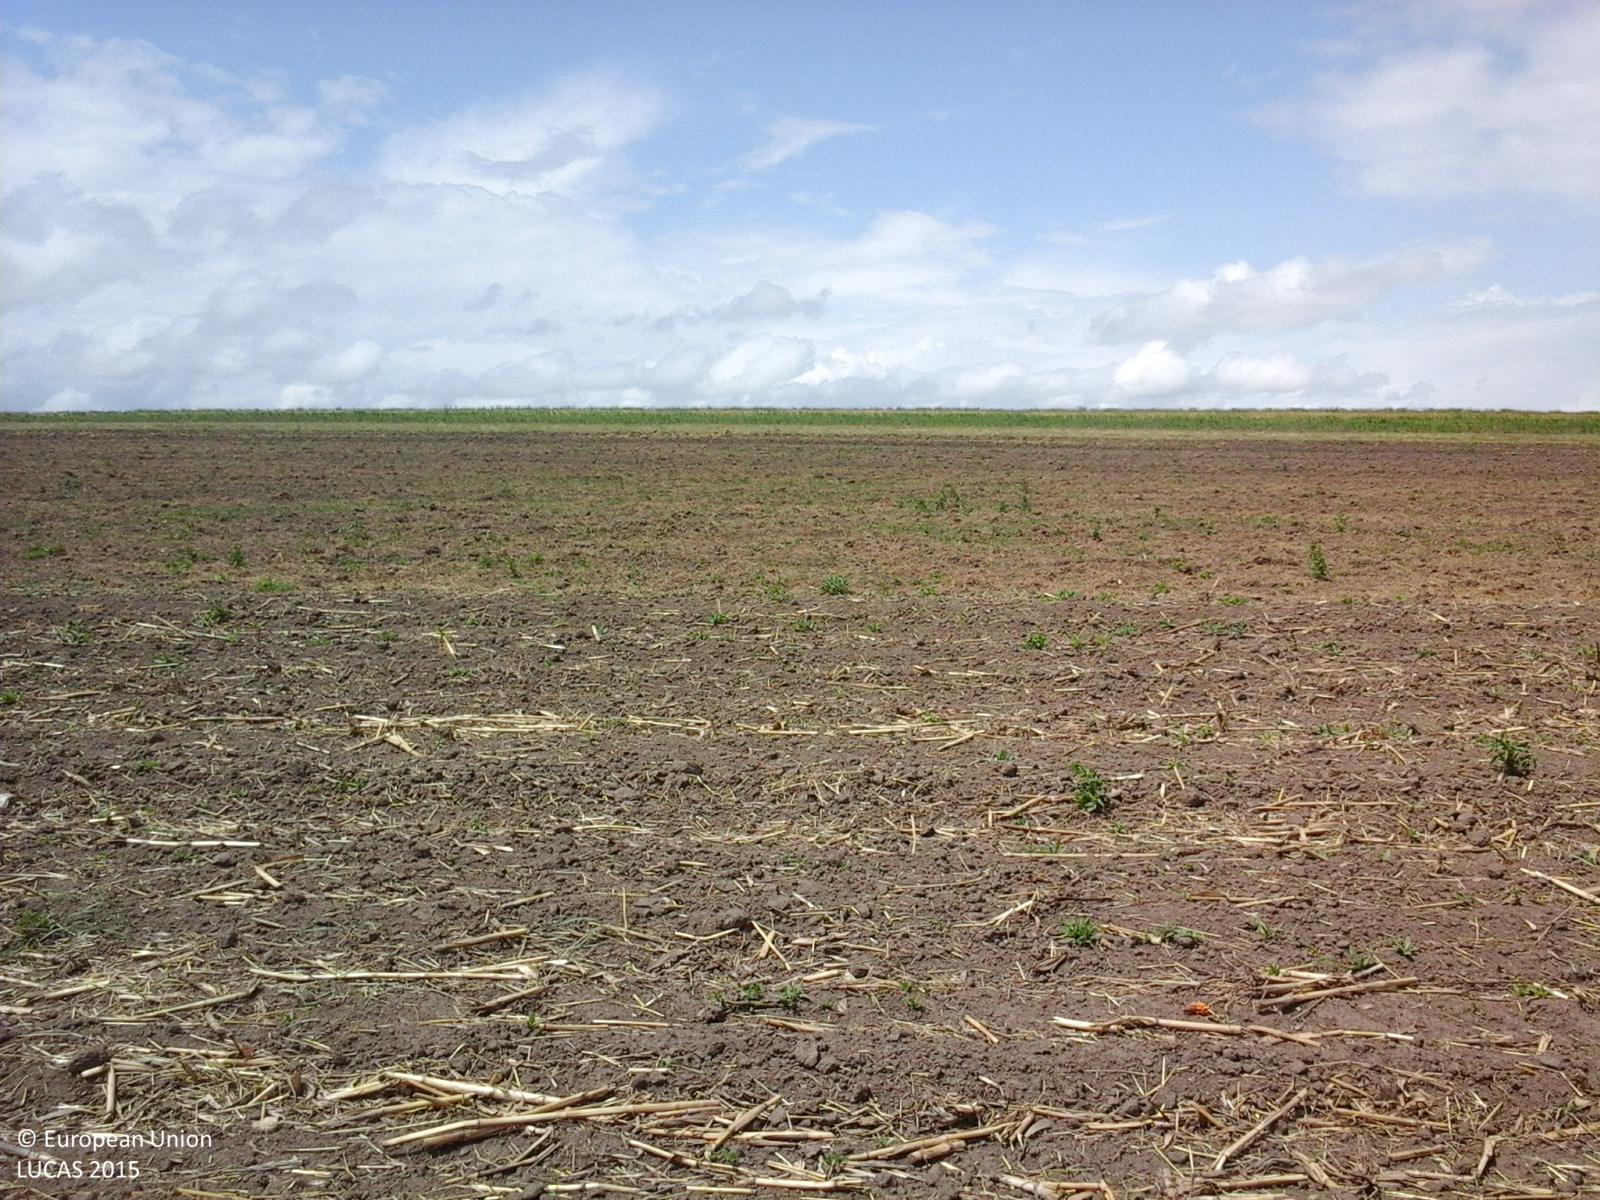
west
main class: Cropland
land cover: Maize
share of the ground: 25 - 50 %
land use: Agriculture (excluding fallow land and kitchen gardens)
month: May
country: RO
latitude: 47.1459
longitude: 26.4231
